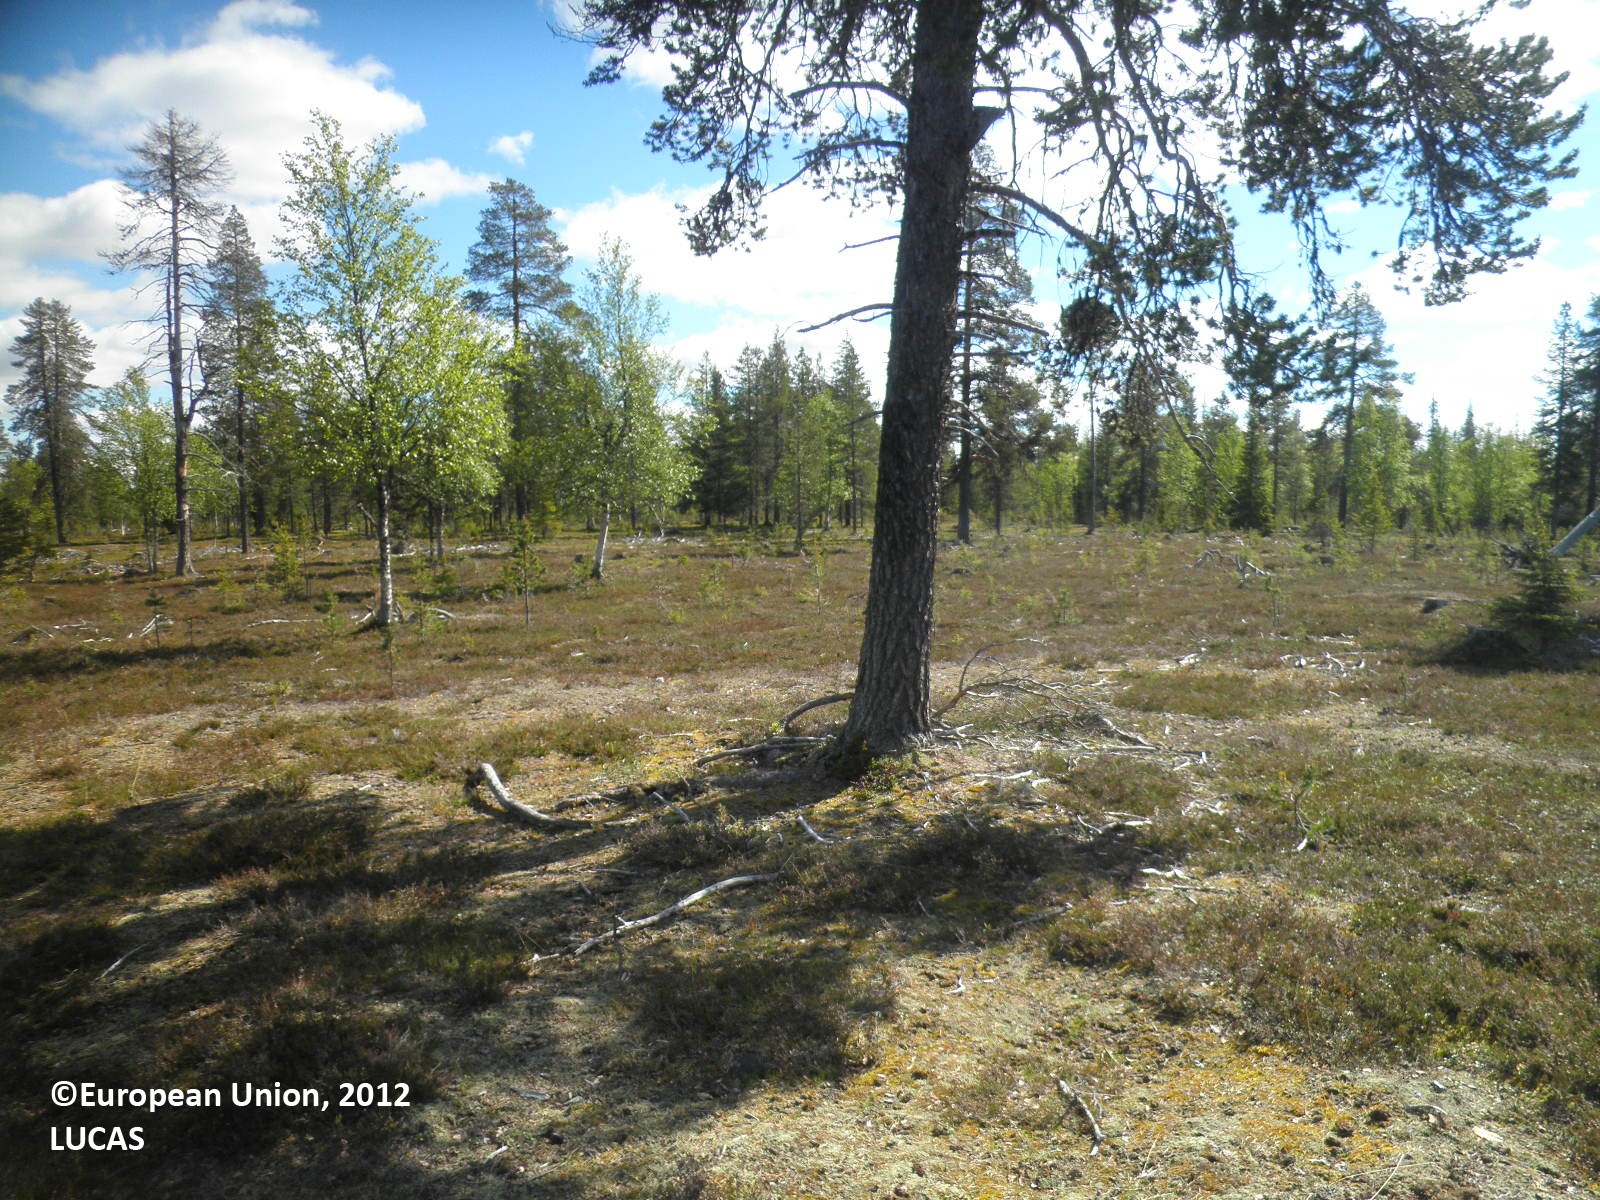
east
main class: Woodland
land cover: Pine dominated mixed woodland
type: boreal forest
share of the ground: 10 - 25 %
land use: Forestry
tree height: > 5 m
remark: Harvested field
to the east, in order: Pine dominated mixed woodland
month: June
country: FI
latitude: 68.2858
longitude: 26.9007
